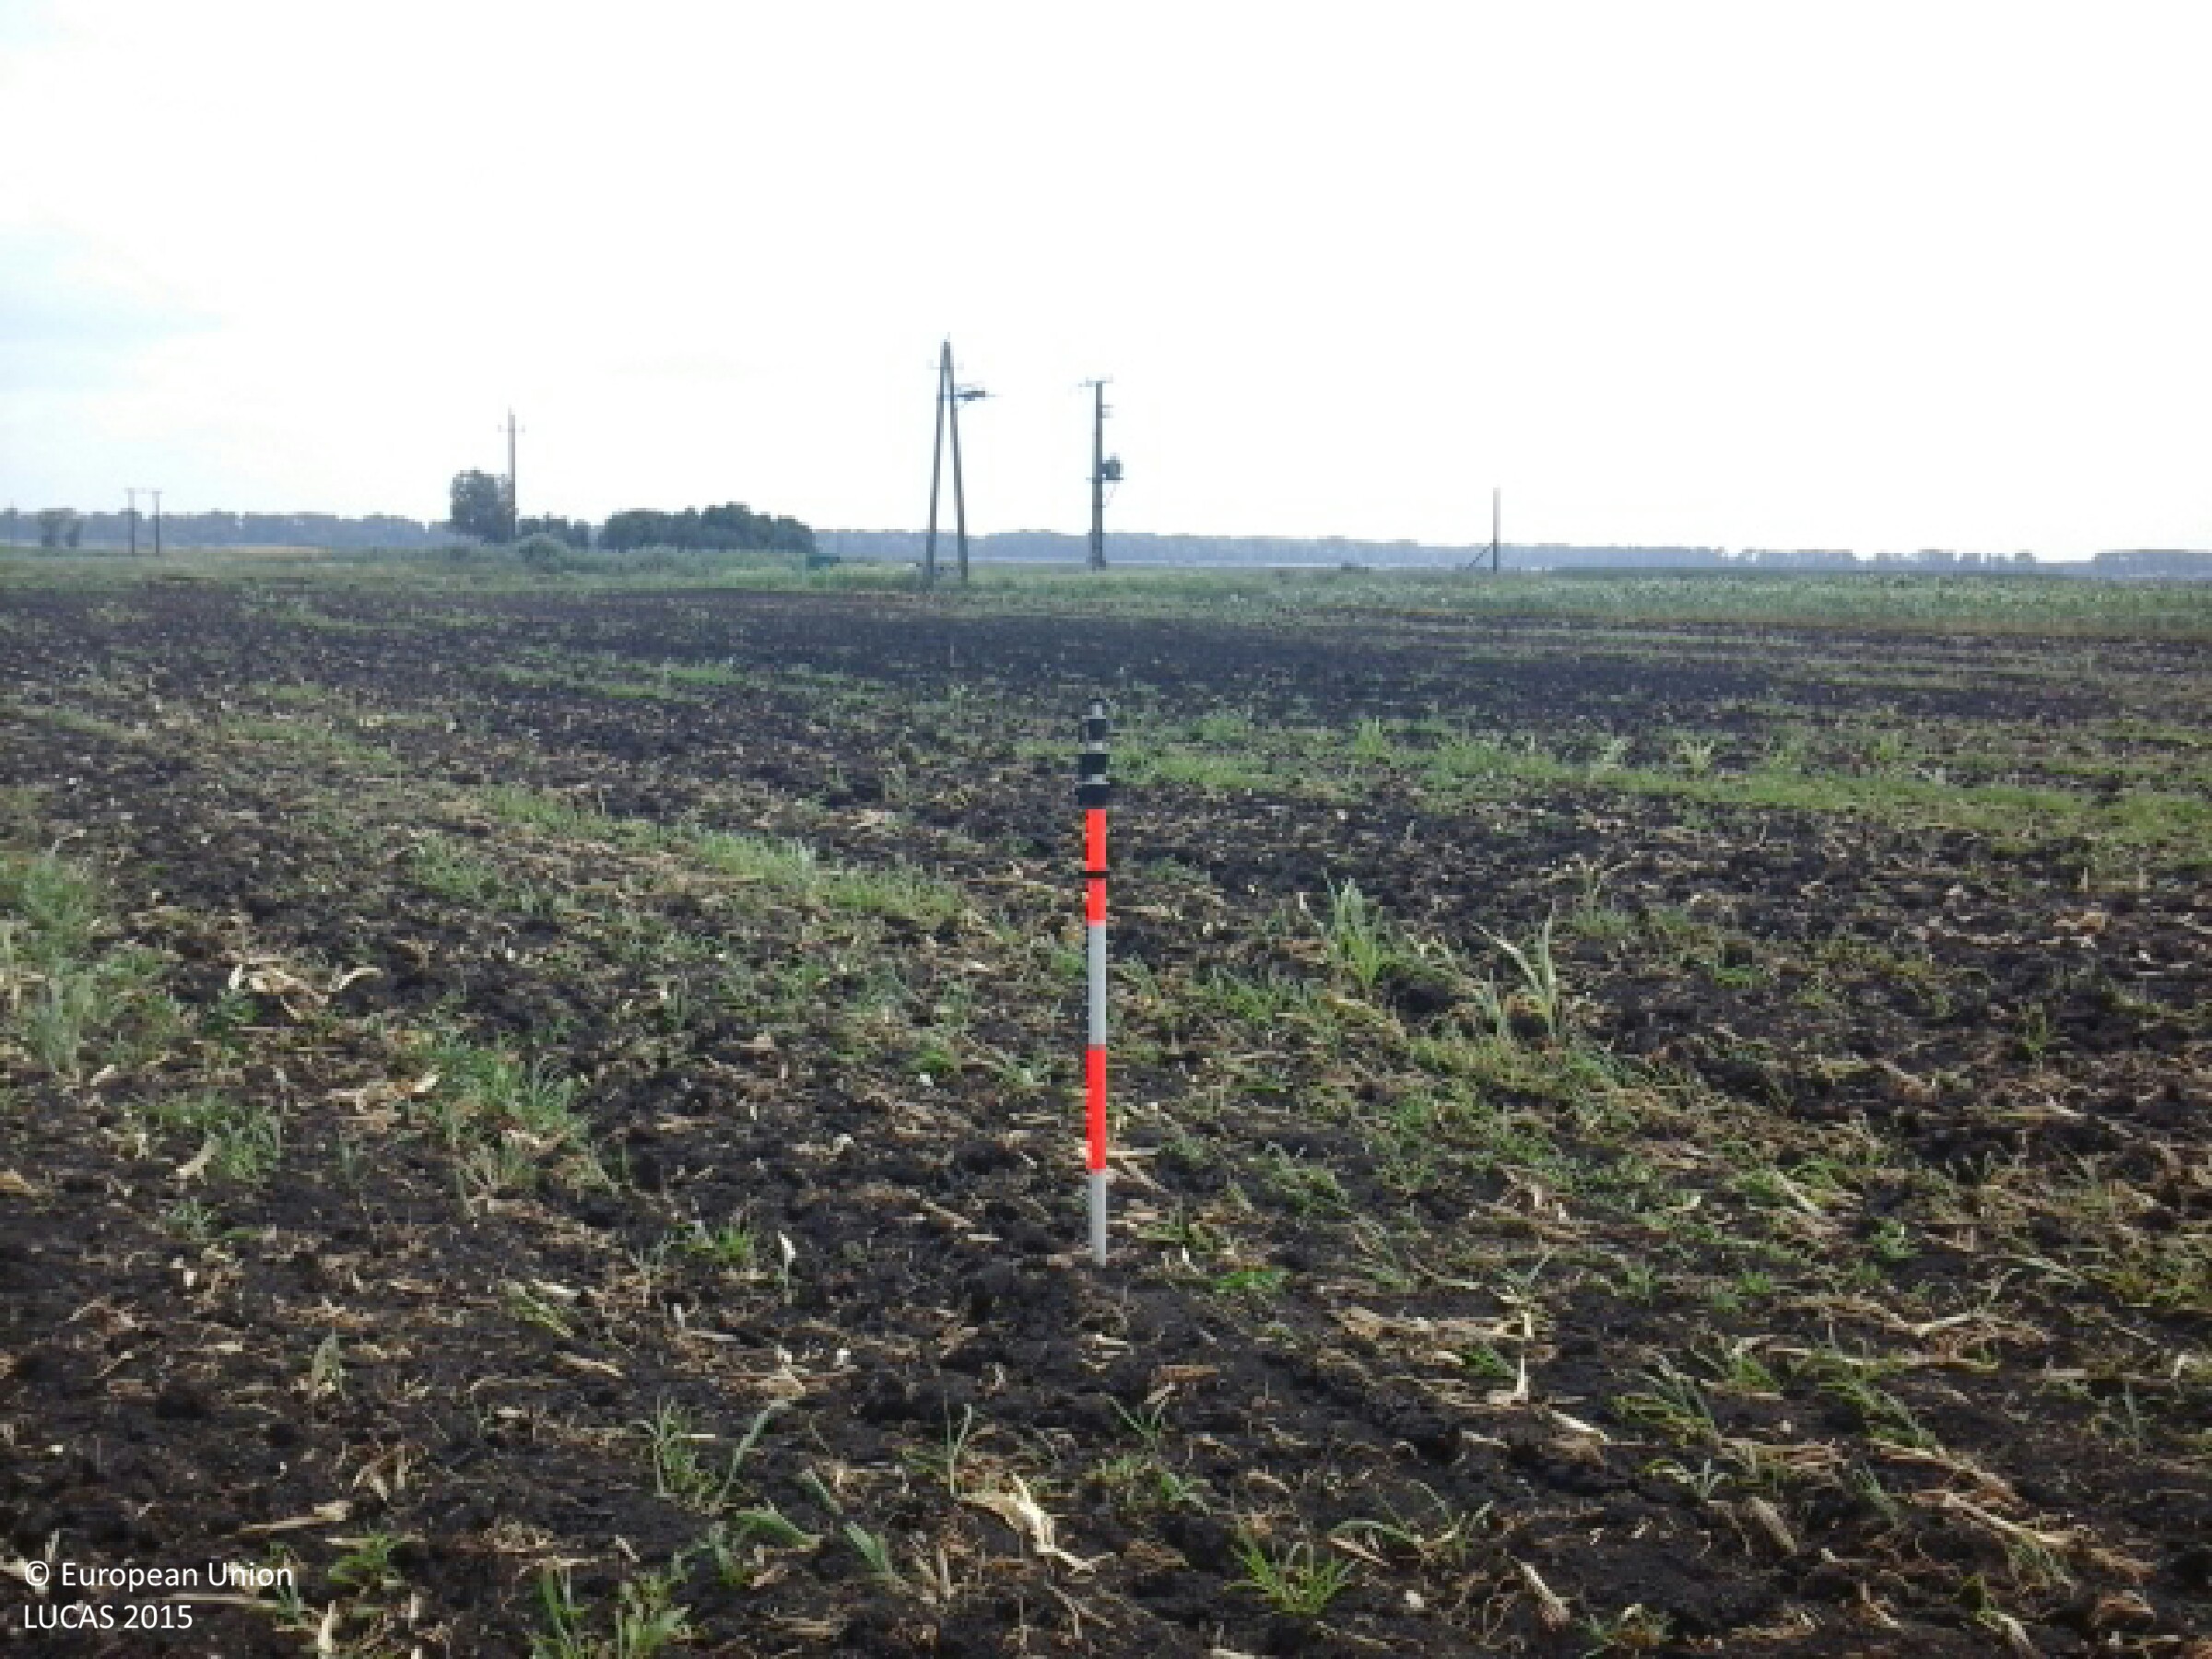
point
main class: Cropland
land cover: Maize
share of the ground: < 10 %
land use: Agriculture (excluding fallow land and kitchen gardens)
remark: Harvested field
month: June
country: HU
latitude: 48.2293
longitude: 21.7481
